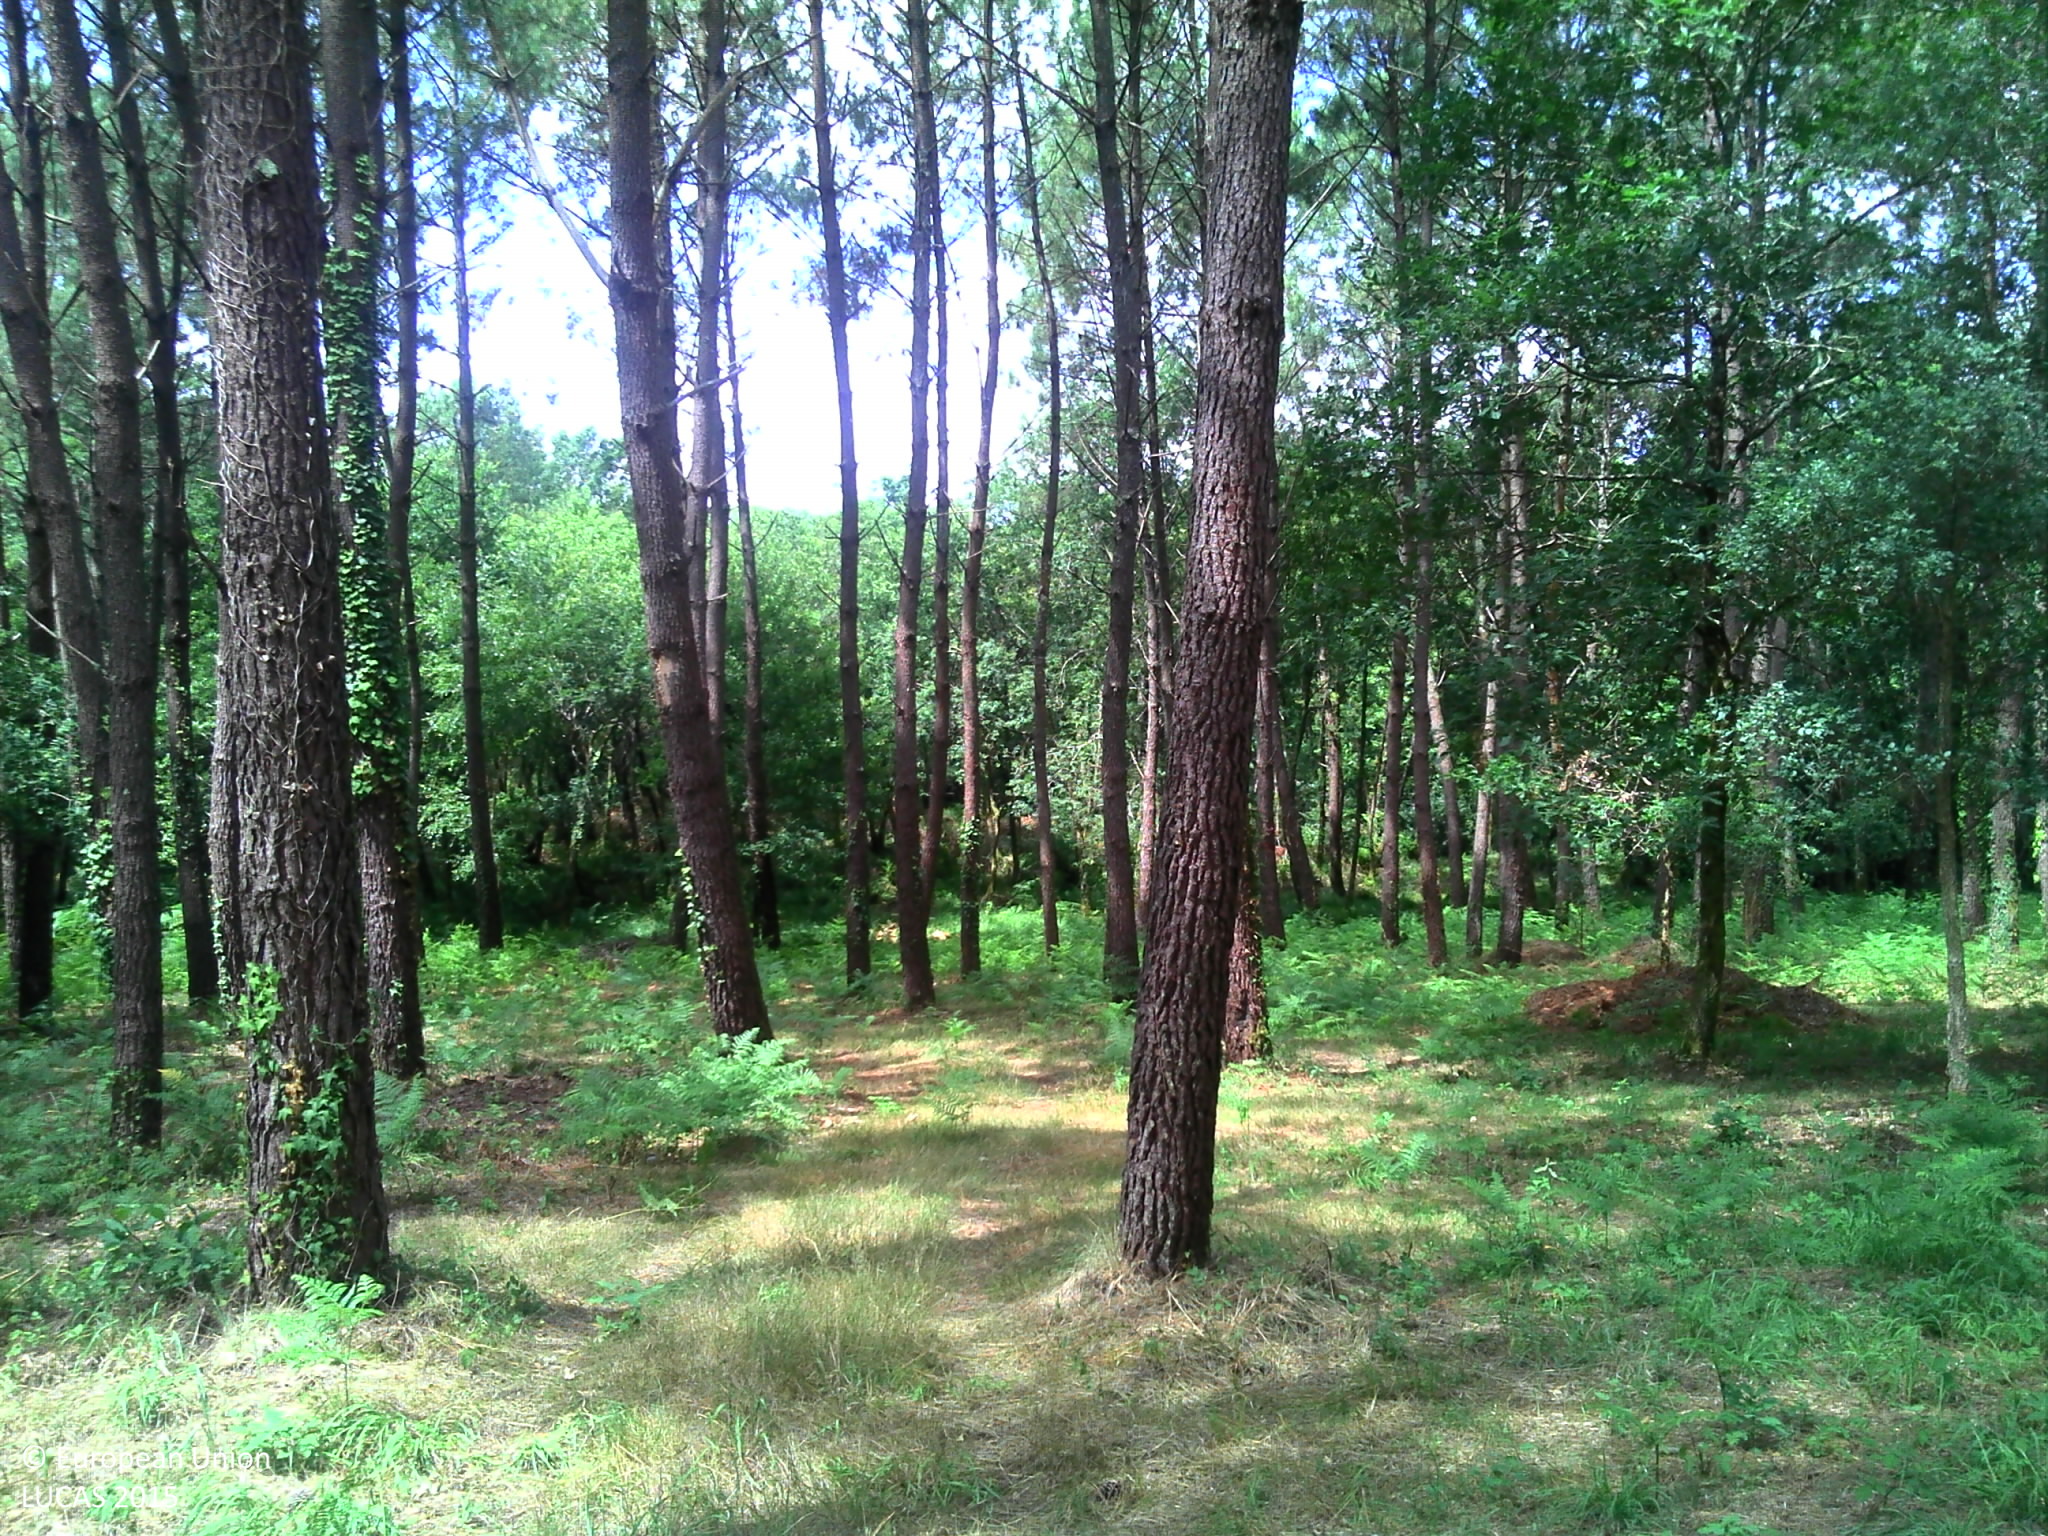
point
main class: Woodland
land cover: Pine dominated coniferous woodland
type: coniferous forest of the mediterranean region
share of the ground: > 75 %
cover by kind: coniferous forest trees 75 %, herbaceous plants 15 %, shrubs 10 %
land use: Forestry
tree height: > 5 m
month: July
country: FR
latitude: 43.8815
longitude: -1.2578
